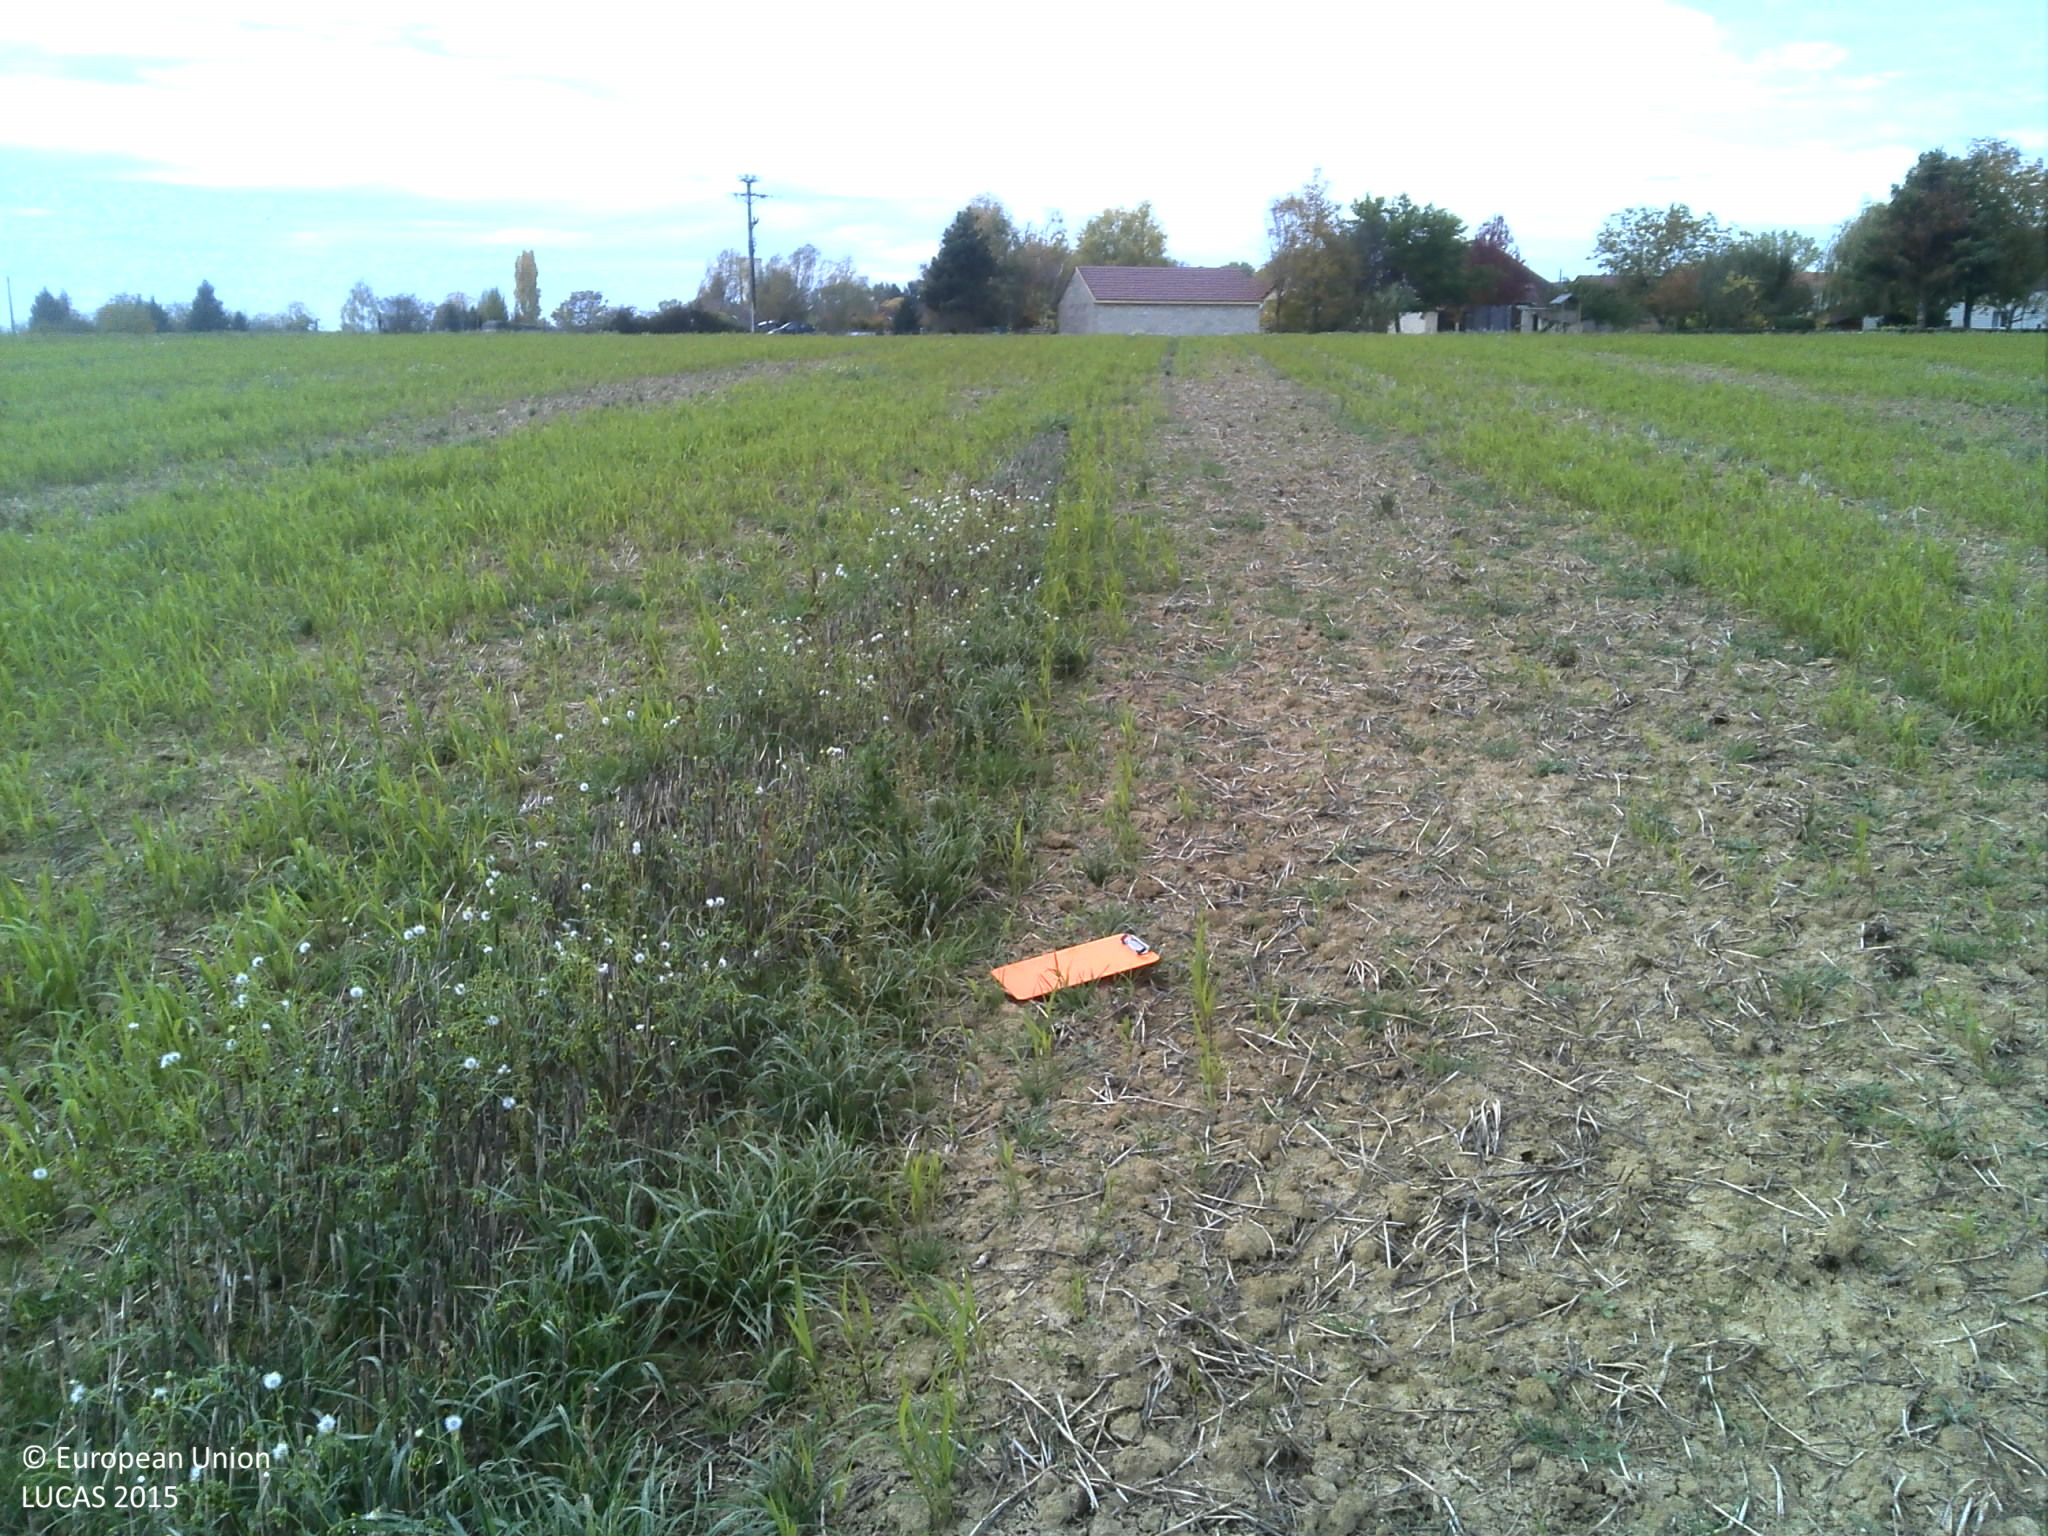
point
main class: Cropland
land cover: Common wheat
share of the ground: 10 - 25 %
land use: Agriculture (excluding fallow land and kitchen gardens)
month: October
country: FR
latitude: 47.1170
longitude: 5.3752
